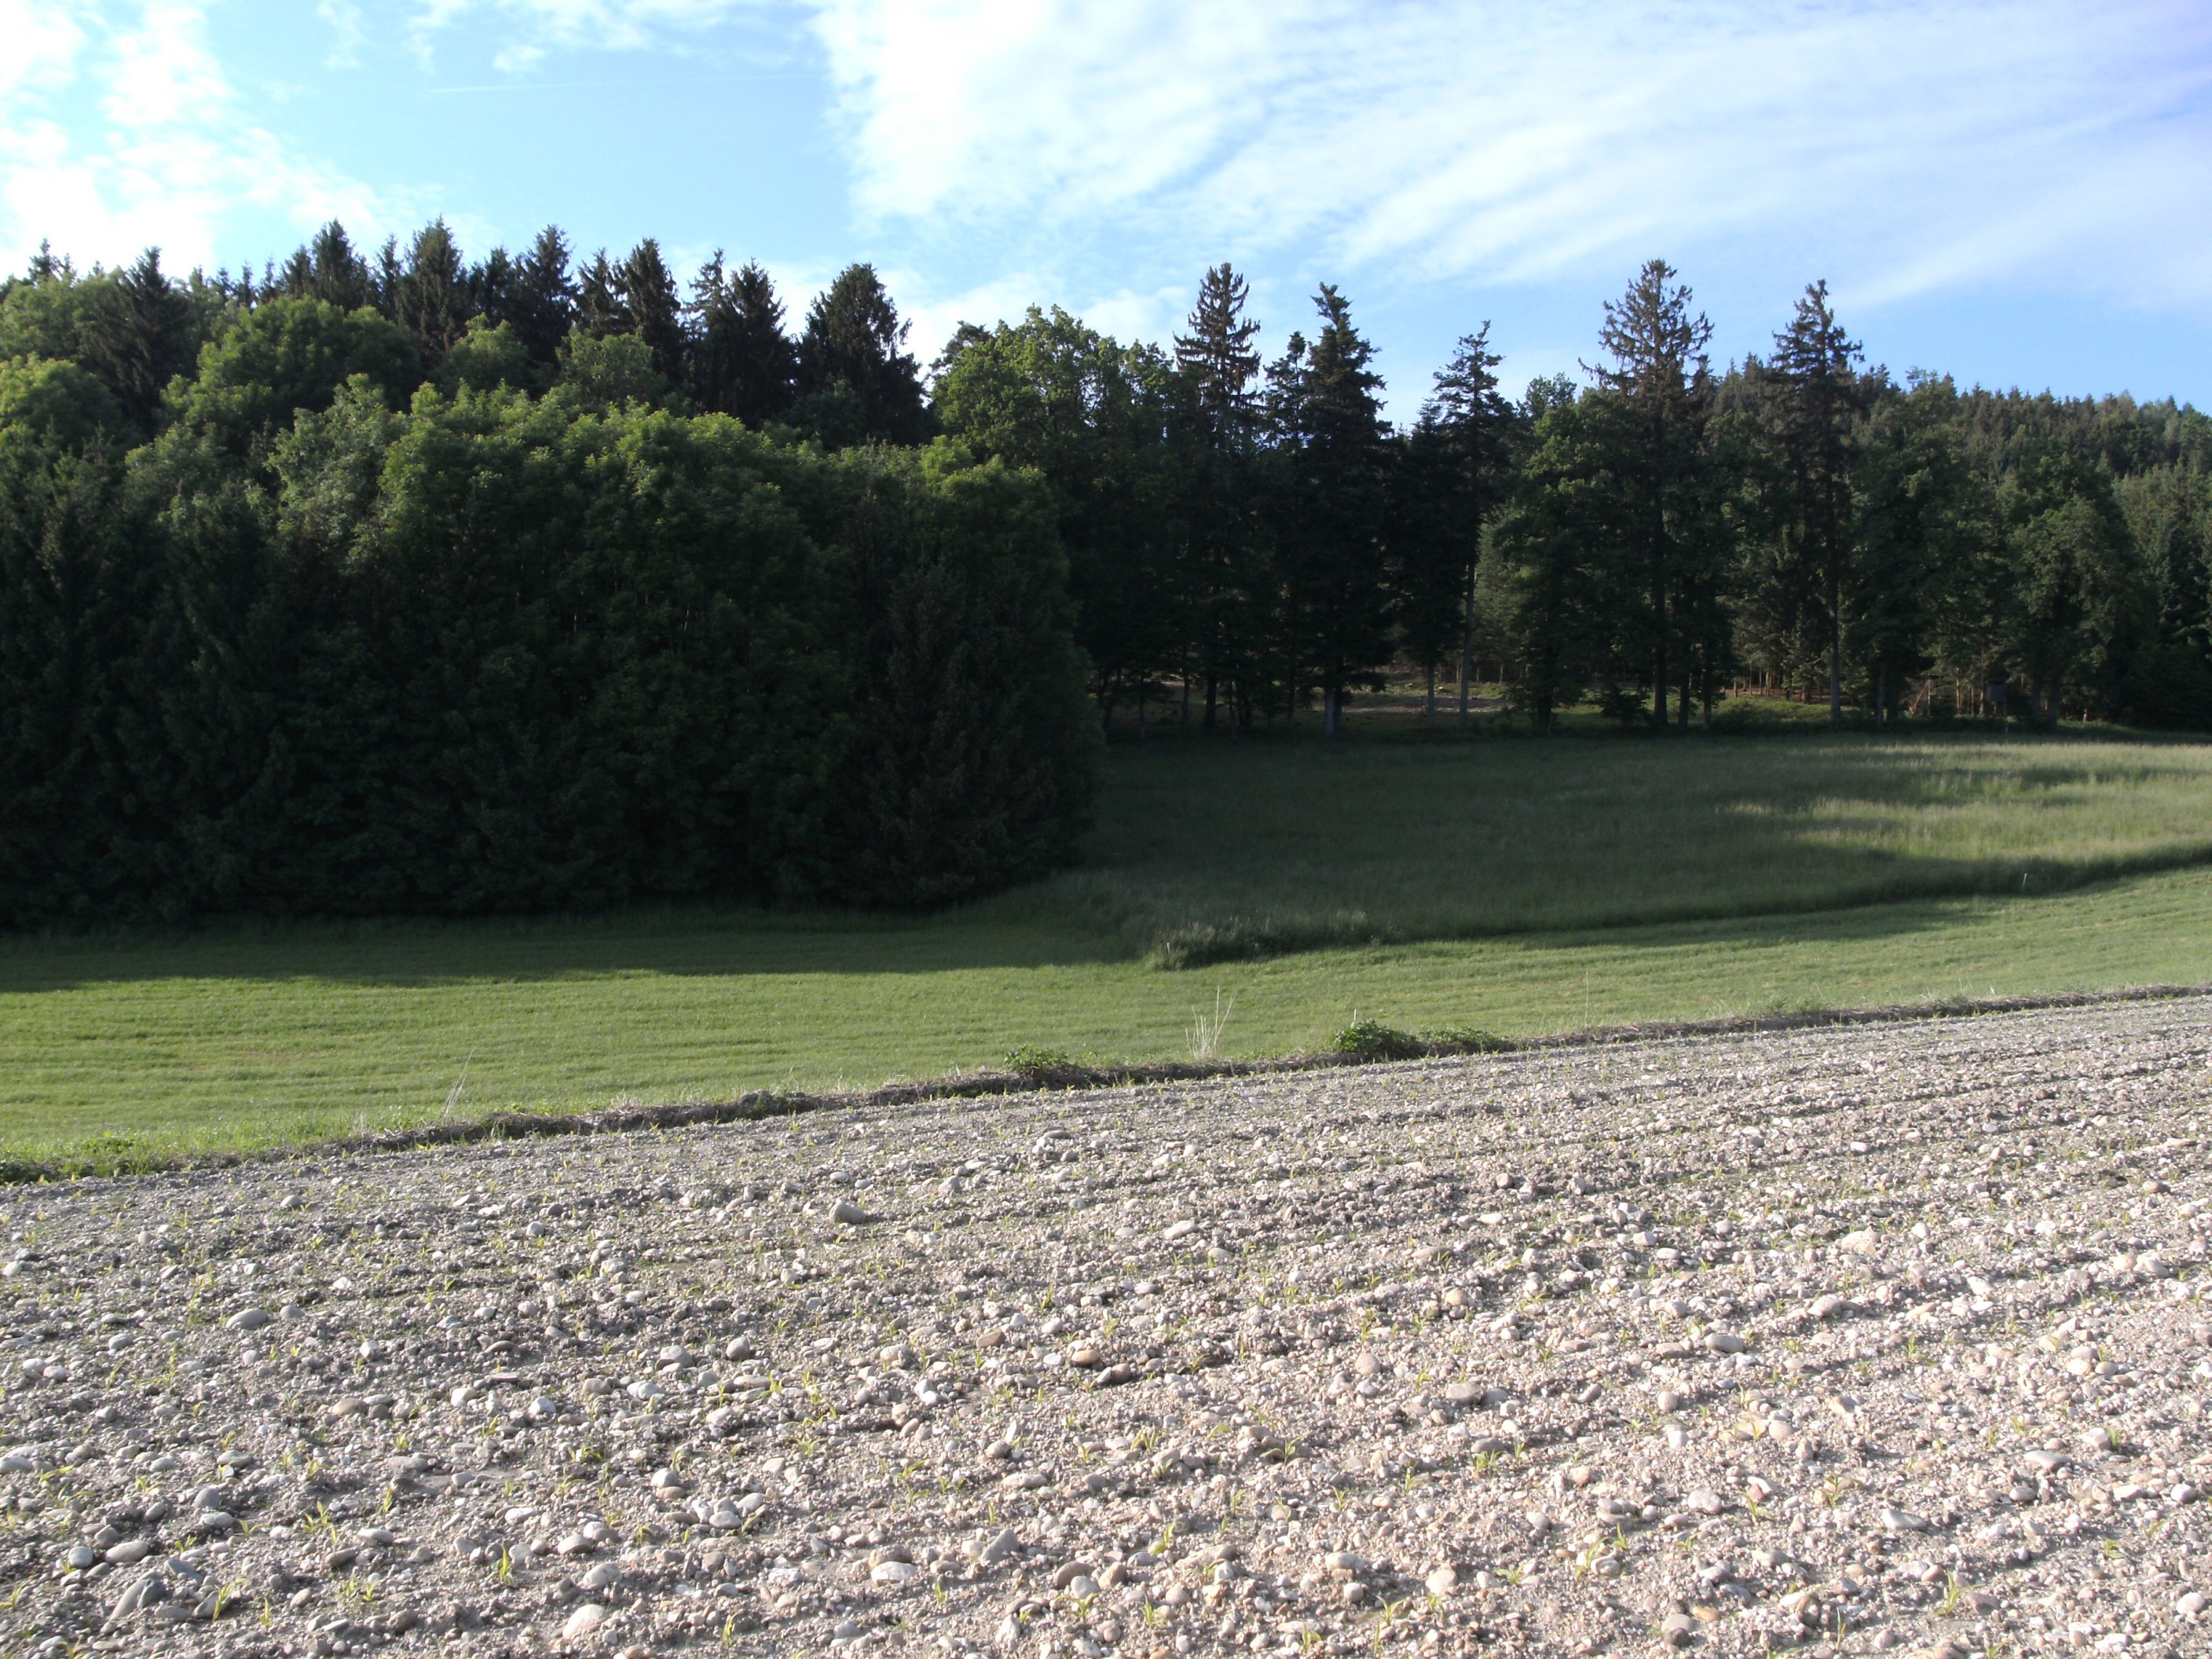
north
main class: Cropland
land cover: Maize
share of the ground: < 10 %
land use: Agriculture (excluding fallow land and kitchen gardens)
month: May
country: AT
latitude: 48.1651
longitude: 13.5892
